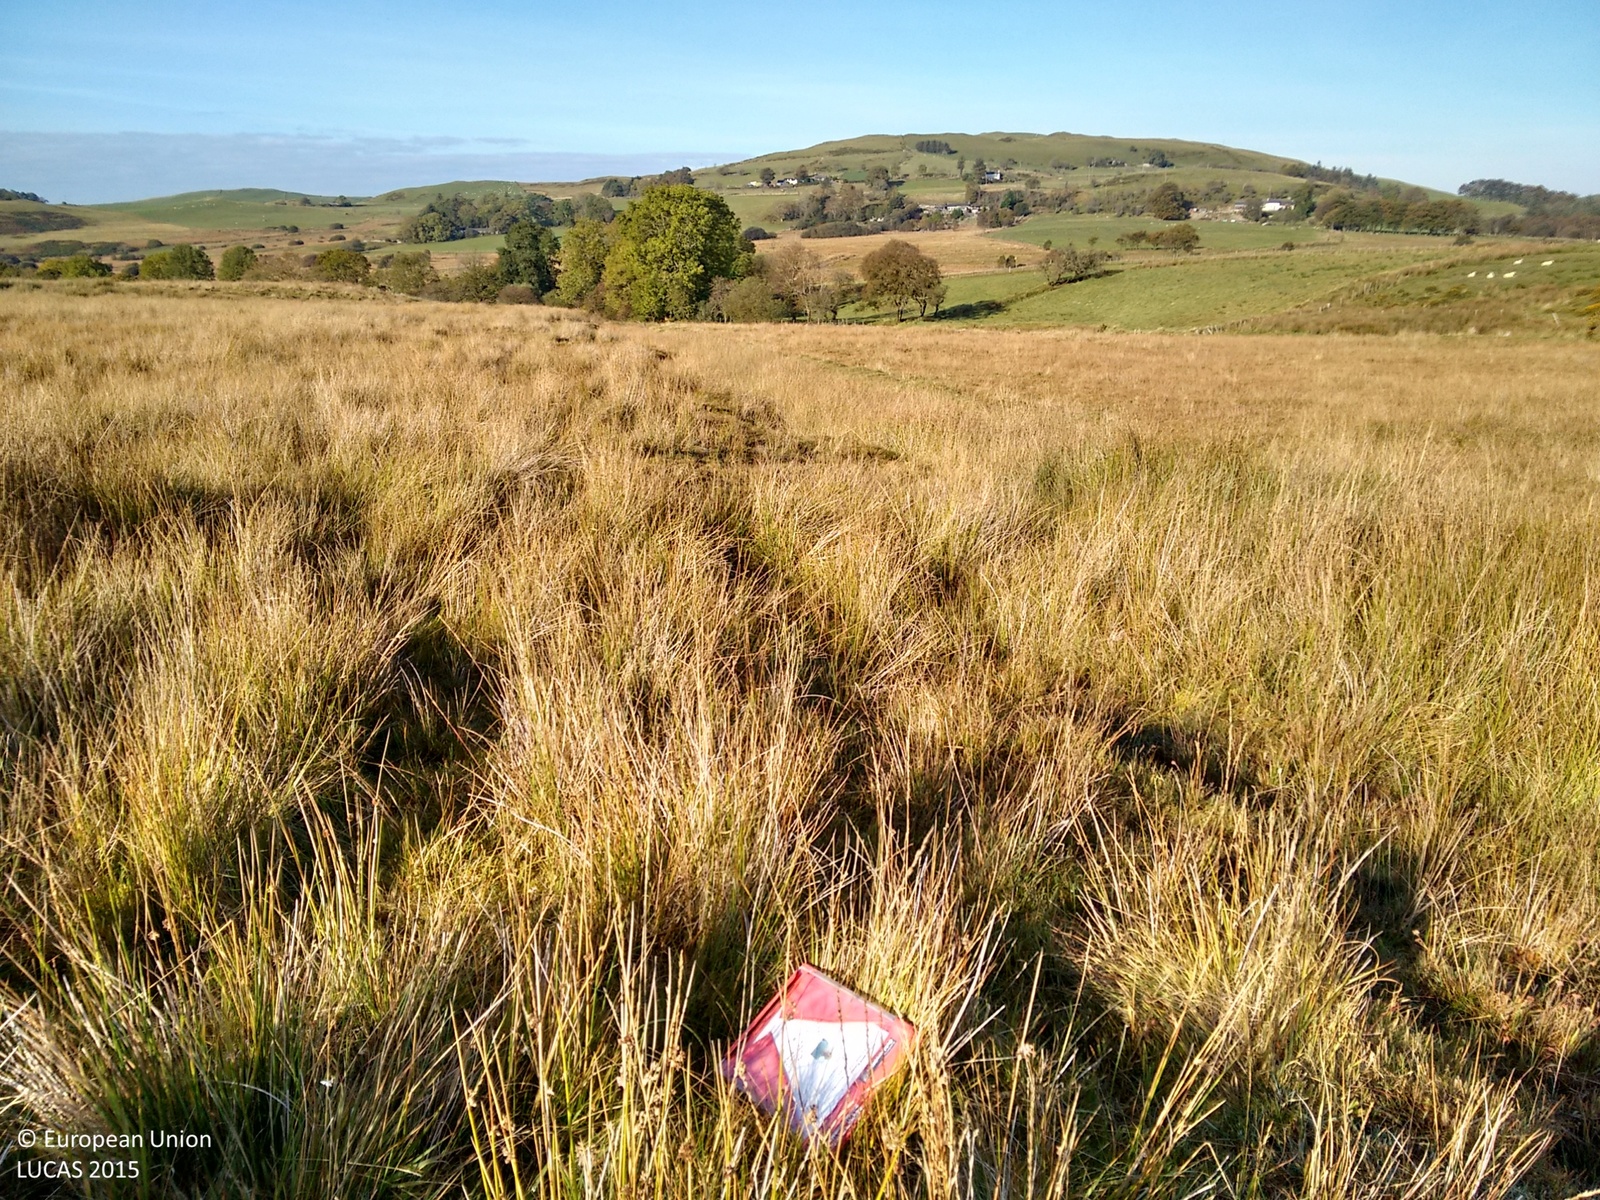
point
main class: Grassland
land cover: Grassland without tree/shrub cover
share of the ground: > 75 %
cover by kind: herbaceous plants 100 %
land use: Agriculture (excluding fallow land and kitchen gardens)
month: October
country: GB
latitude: 52.3633
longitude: -3.8515
